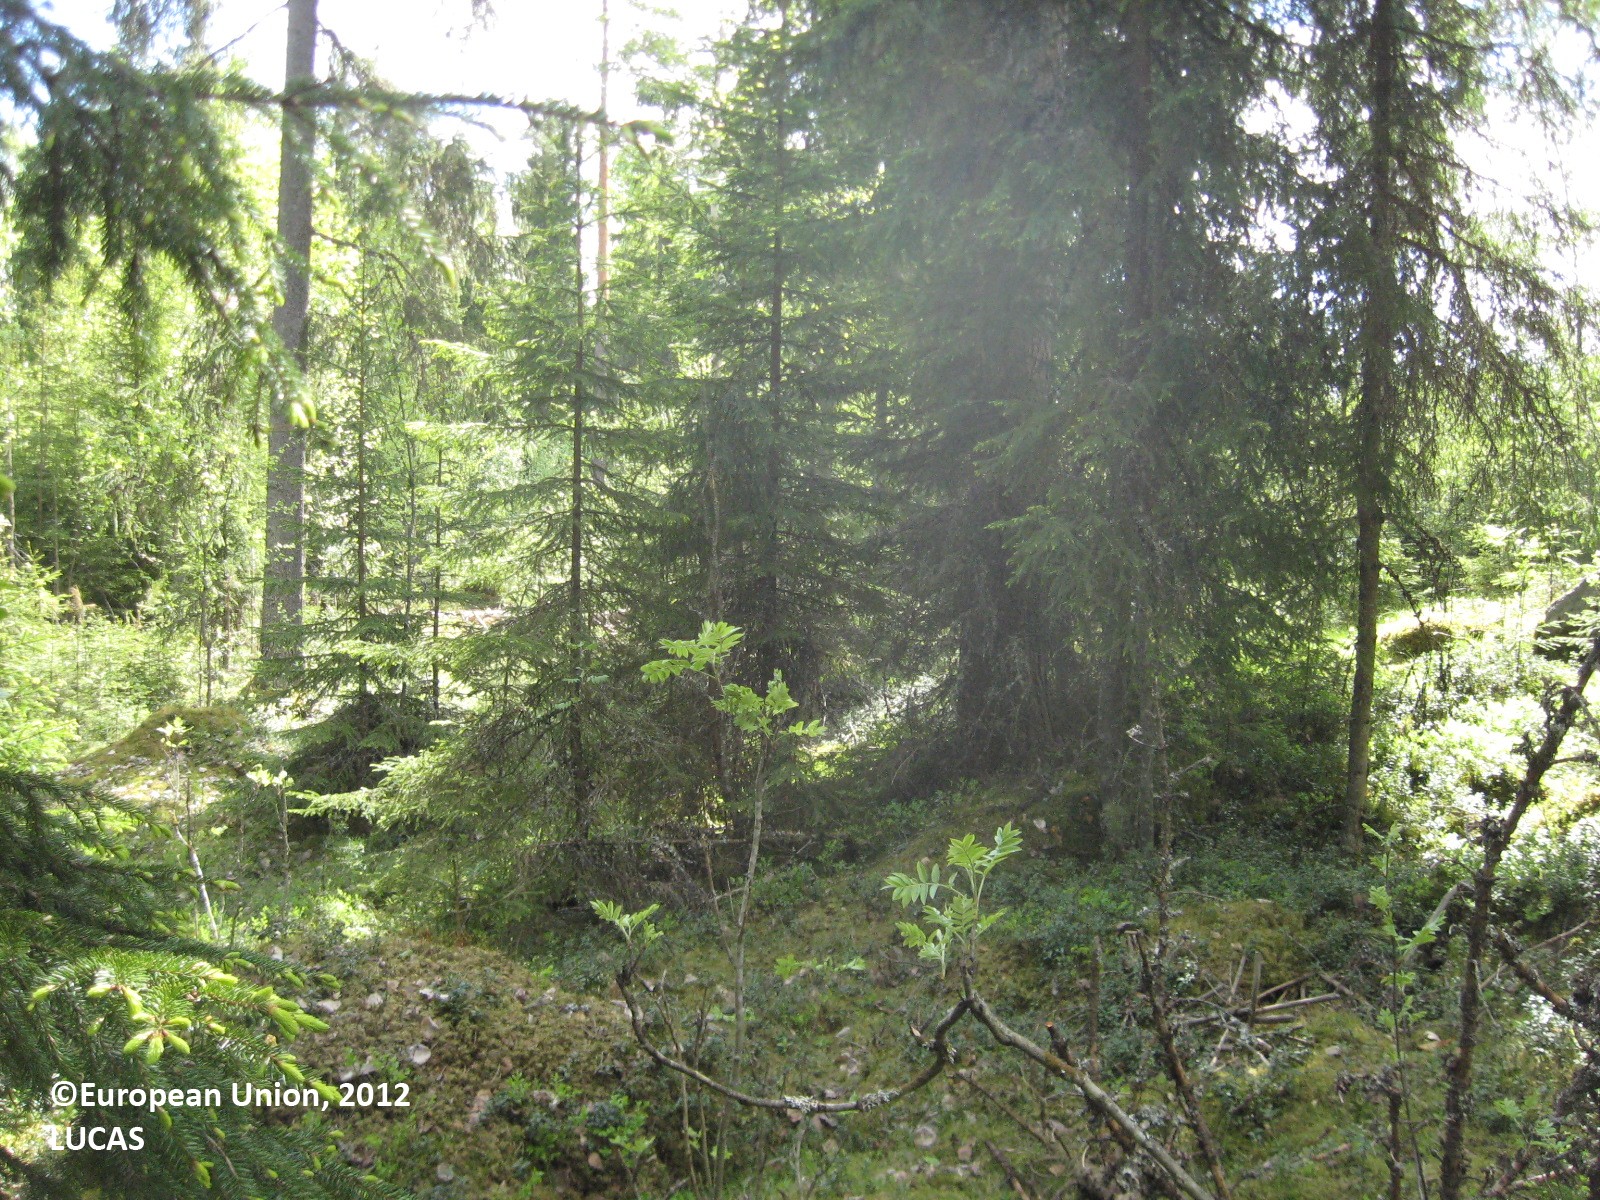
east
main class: Woodland
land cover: Spruce dominated coniferous woodland
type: boreal forest
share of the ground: 50 - 75 %
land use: Forestry
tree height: > 5 m
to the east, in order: Spruce dominated coniferous woodland; Other mixed woodland; Tracks; Other mixed woodland; Spruce dominated coniferous woodland
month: May
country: FI
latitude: 61.7343
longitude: 22.1527
